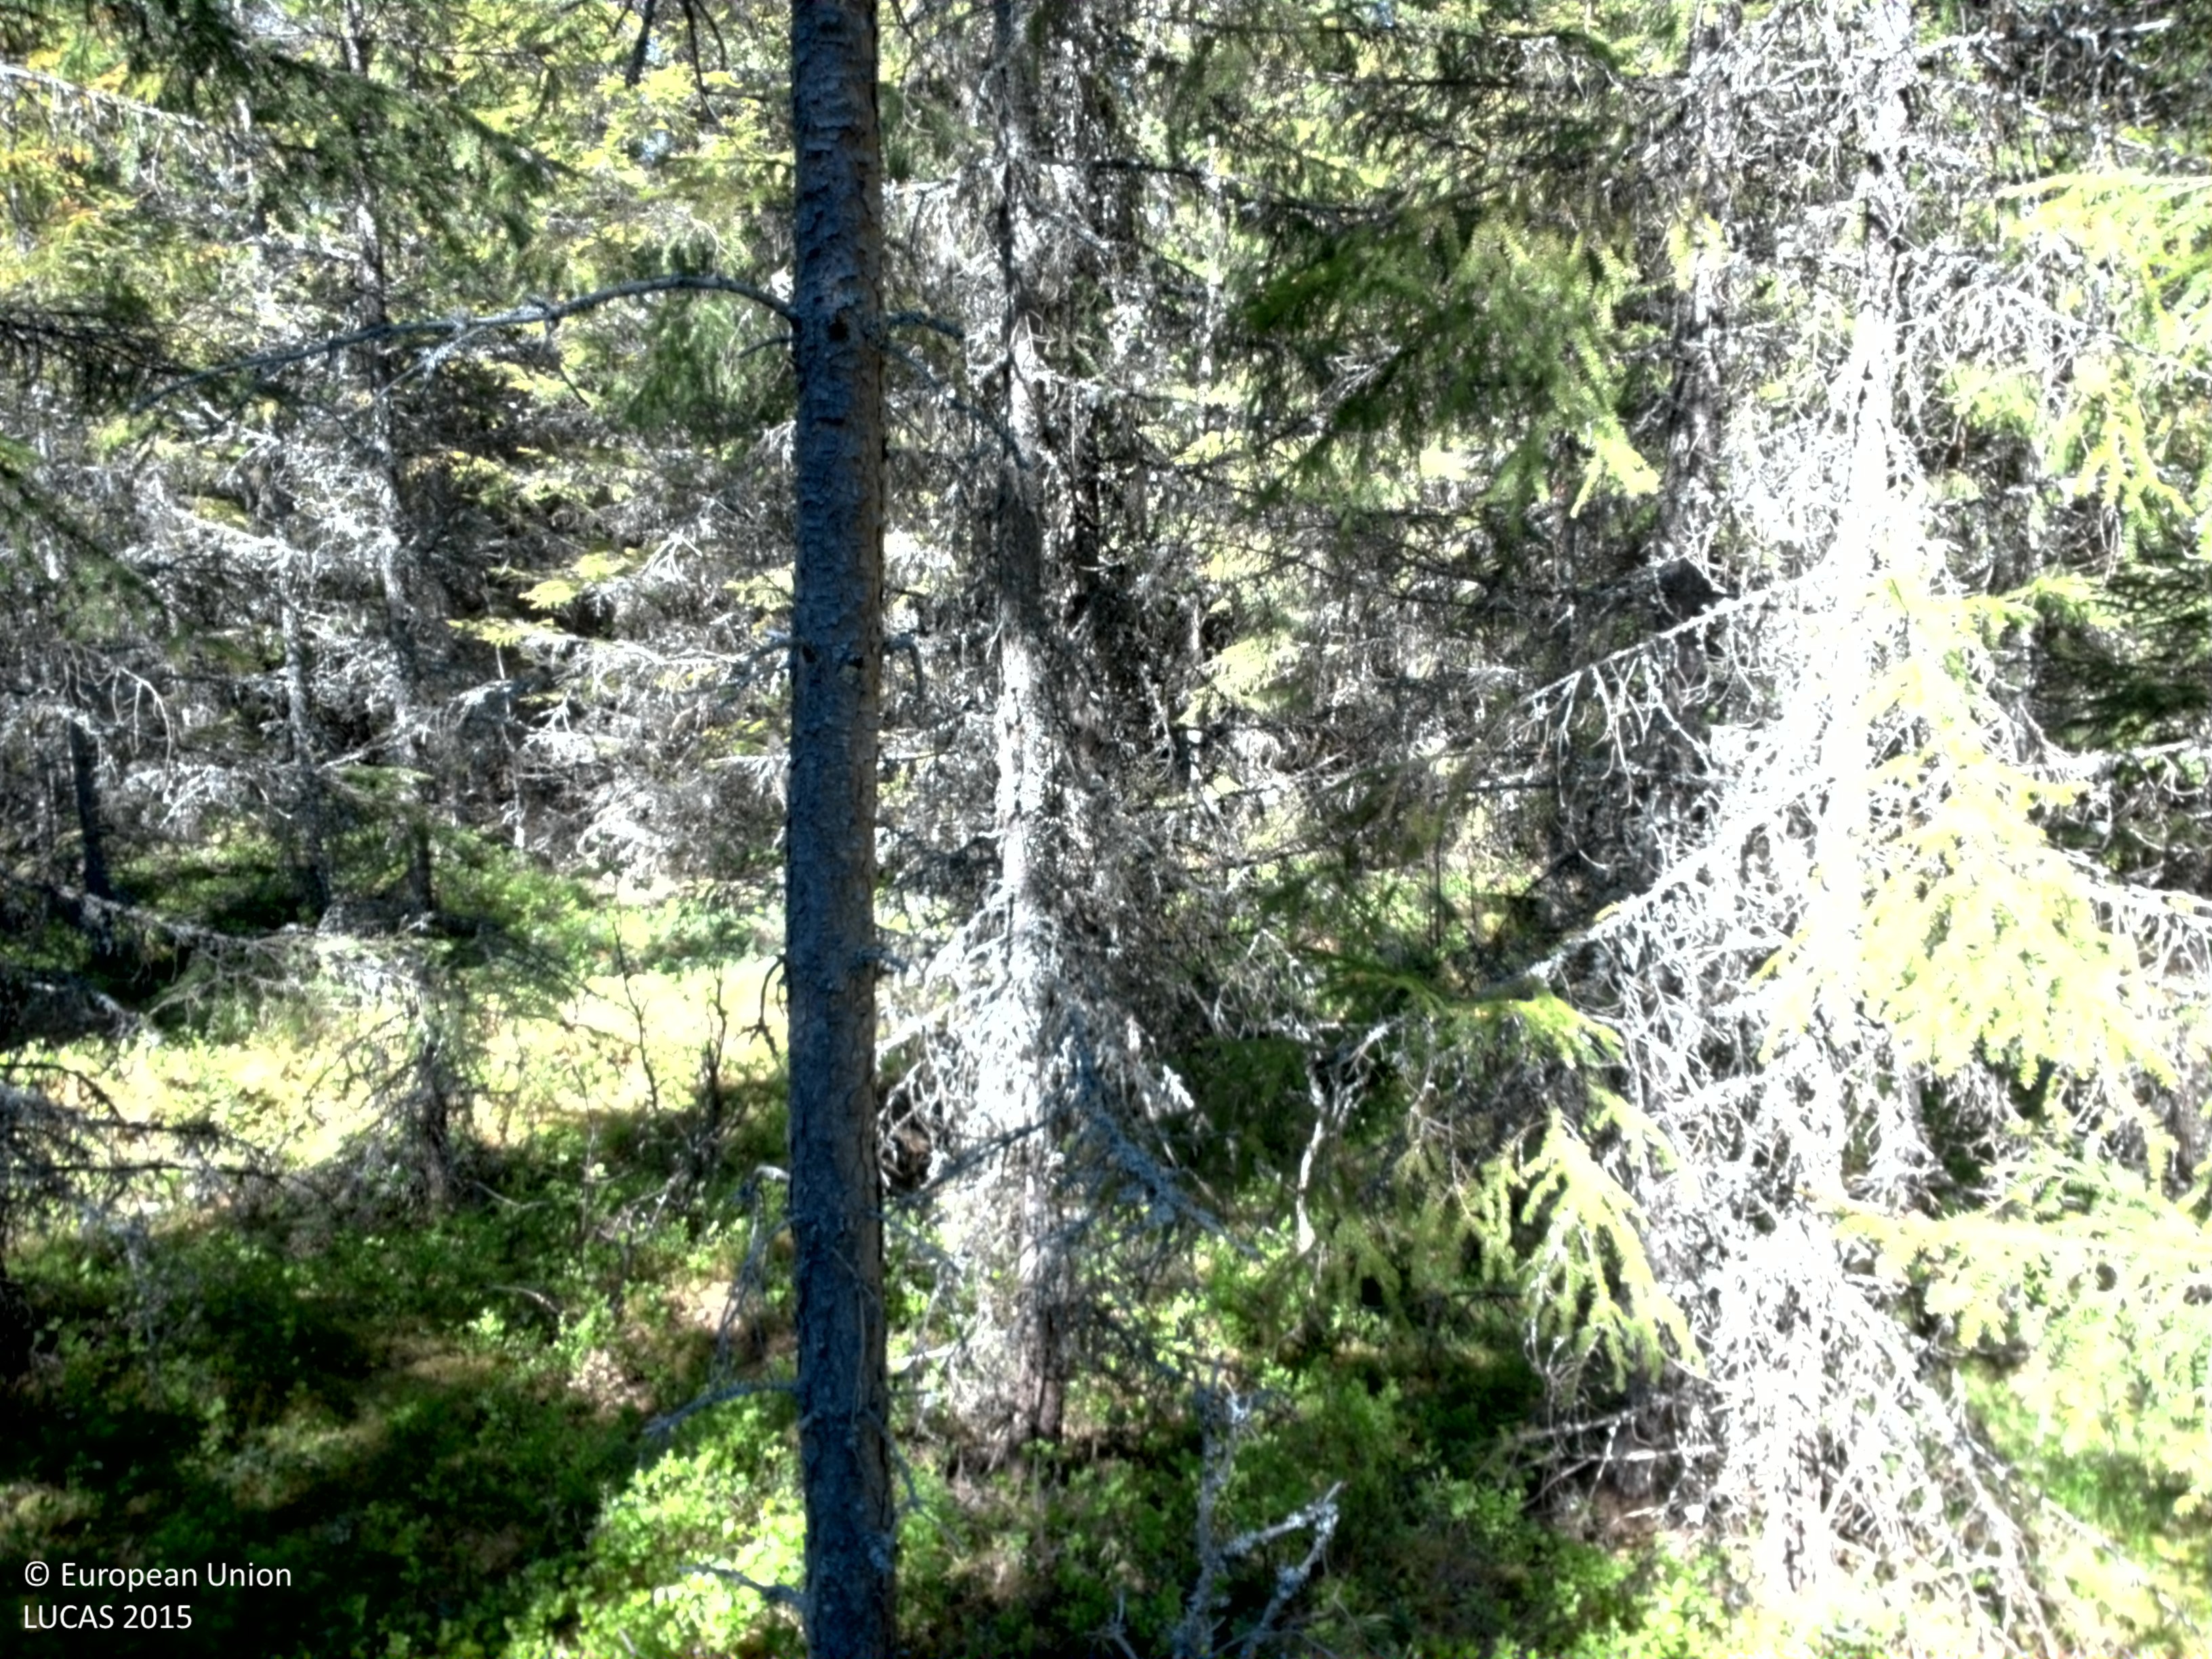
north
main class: Woodland
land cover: Spruce dominated coniferous woodland
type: boreal forest
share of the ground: 50 - 75 %
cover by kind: coniferous forest trees 65 %, shrubs 25 %, broadleaved forest trees 5 %, lichens and mosses 5 %
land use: Forestry
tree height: > 5 m
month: June
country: SE
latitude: 60.4325
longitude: 13.2062
